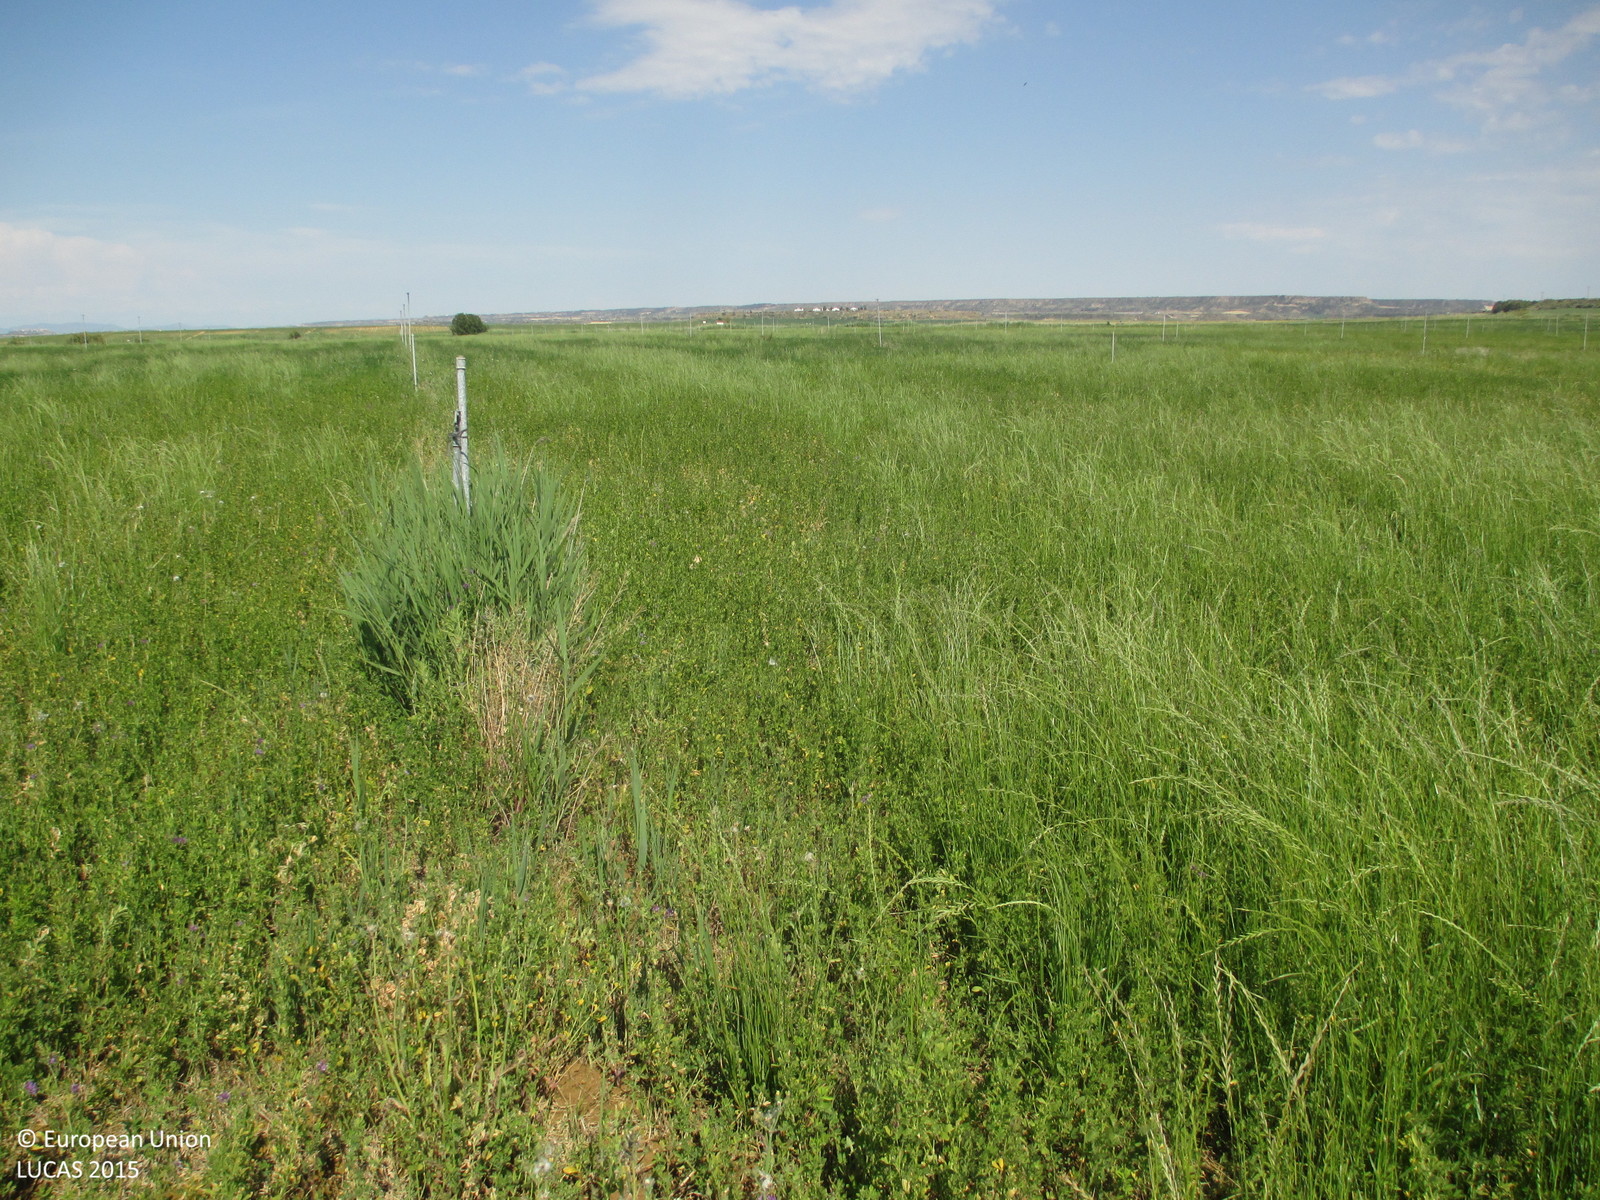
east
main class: Cropland
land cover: Lucerne
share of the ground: > 75 %
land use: Agriculture (excluding fallow land and kitchen gardens)
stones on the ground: < 10 %
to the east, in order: Lucerne
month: May
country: ES
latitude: 41.9057
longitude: -0.1572
